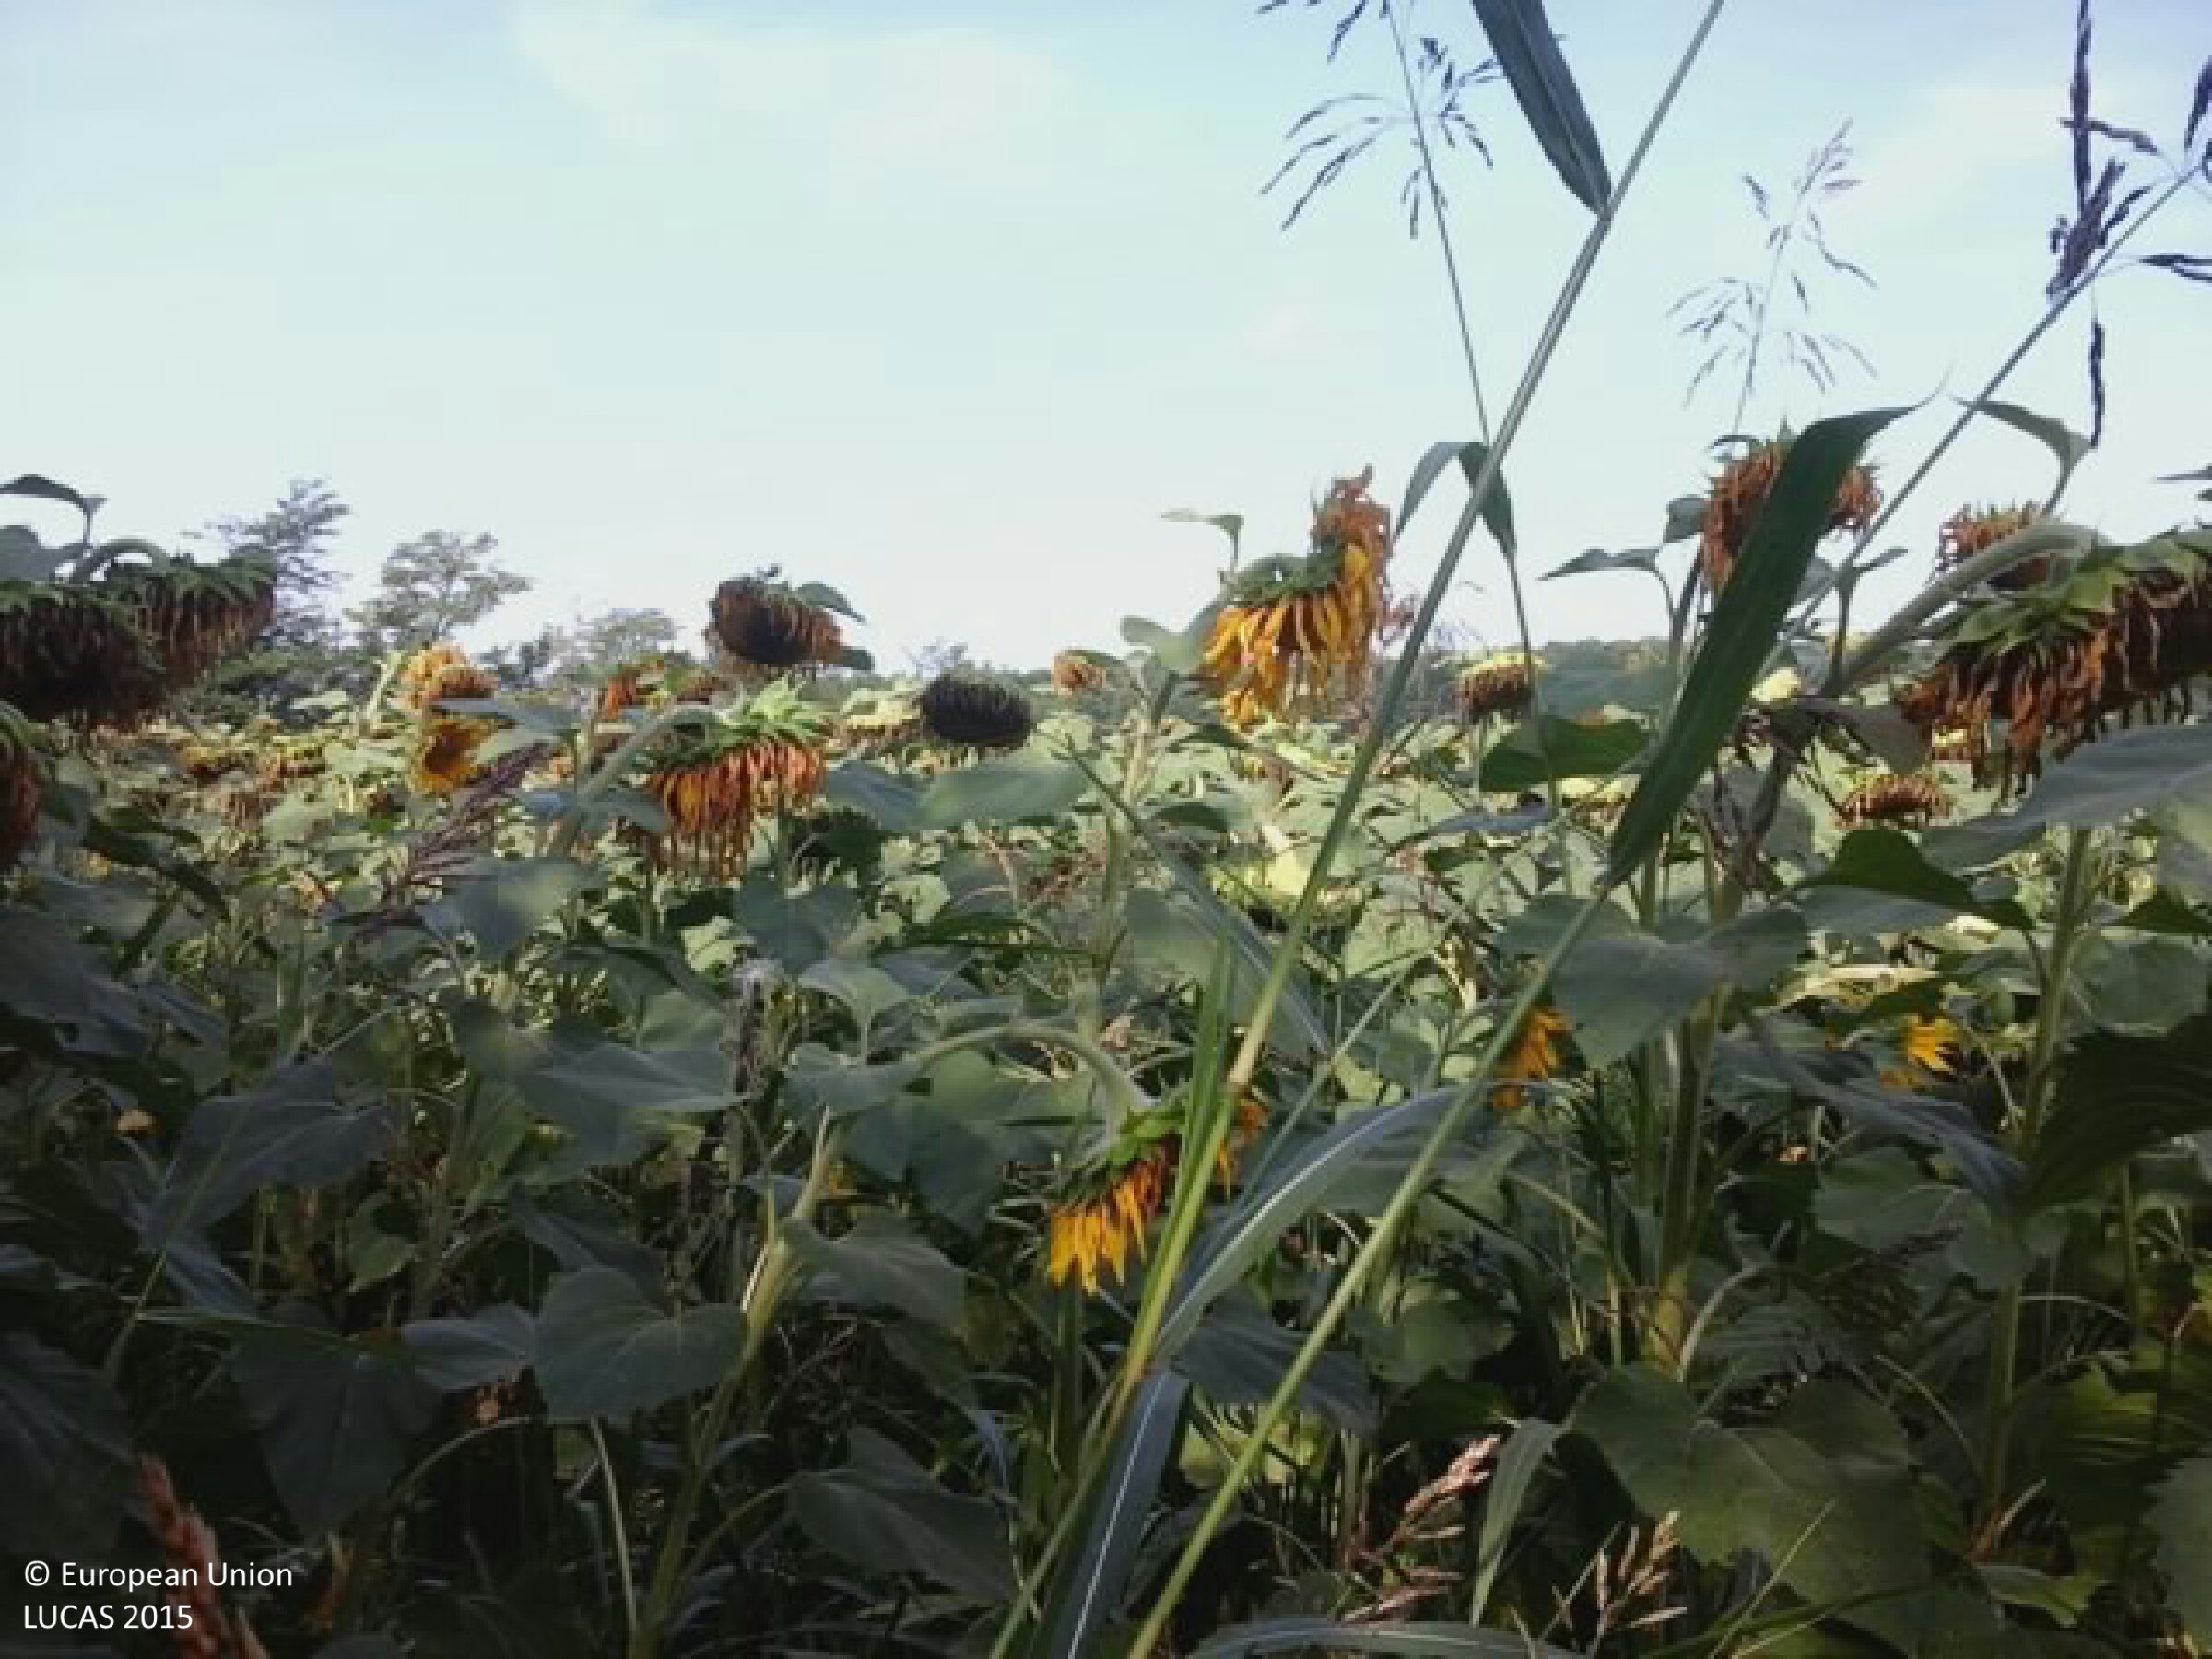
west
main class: Cropland
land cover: Sunflower
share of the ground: > 75 %
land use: Agriculture (excluding fallow land and kitchen gardens)
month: August
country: HU
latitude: 46.6353
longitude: 18.1730
